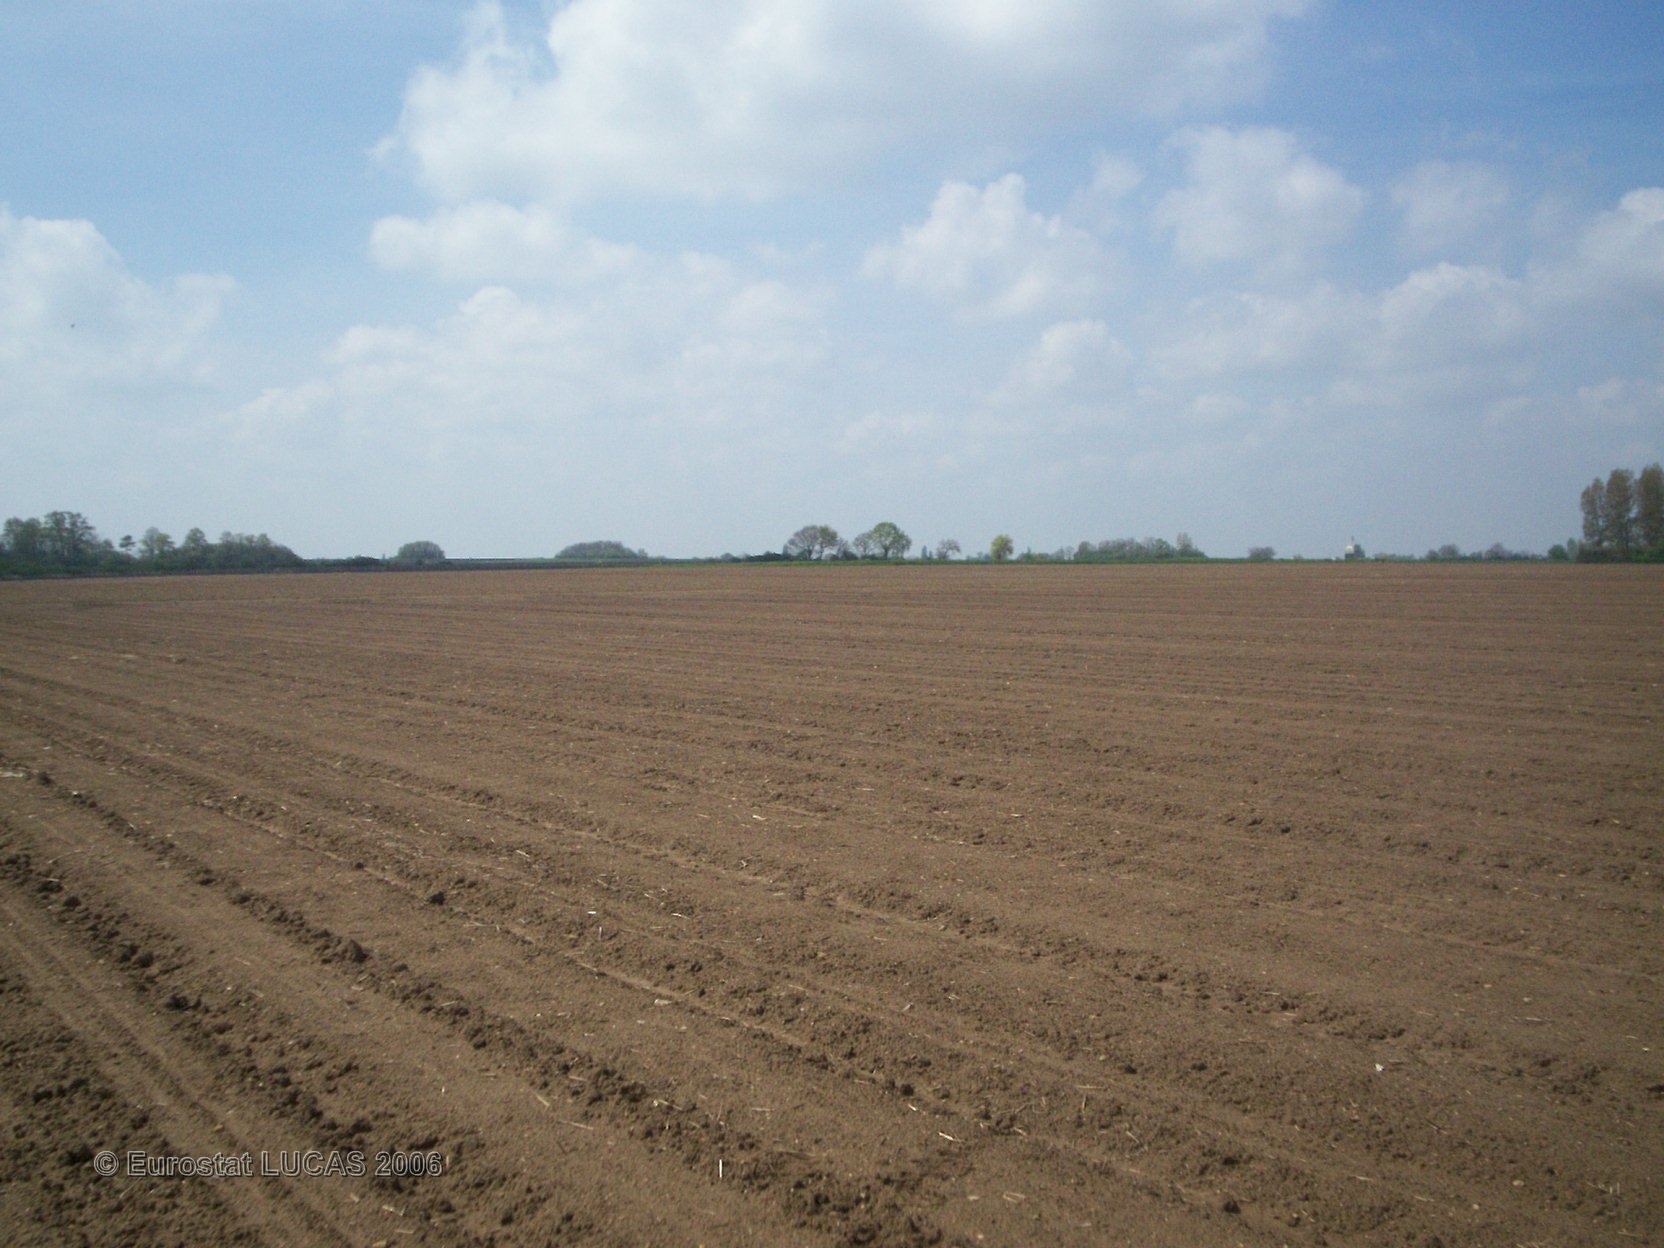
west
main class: Cropland
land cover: Sunflower
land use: Agriculture (excluding fallow land and kitchen gardens)
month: April
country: FR
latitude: 47.2608
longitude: -0.3764
